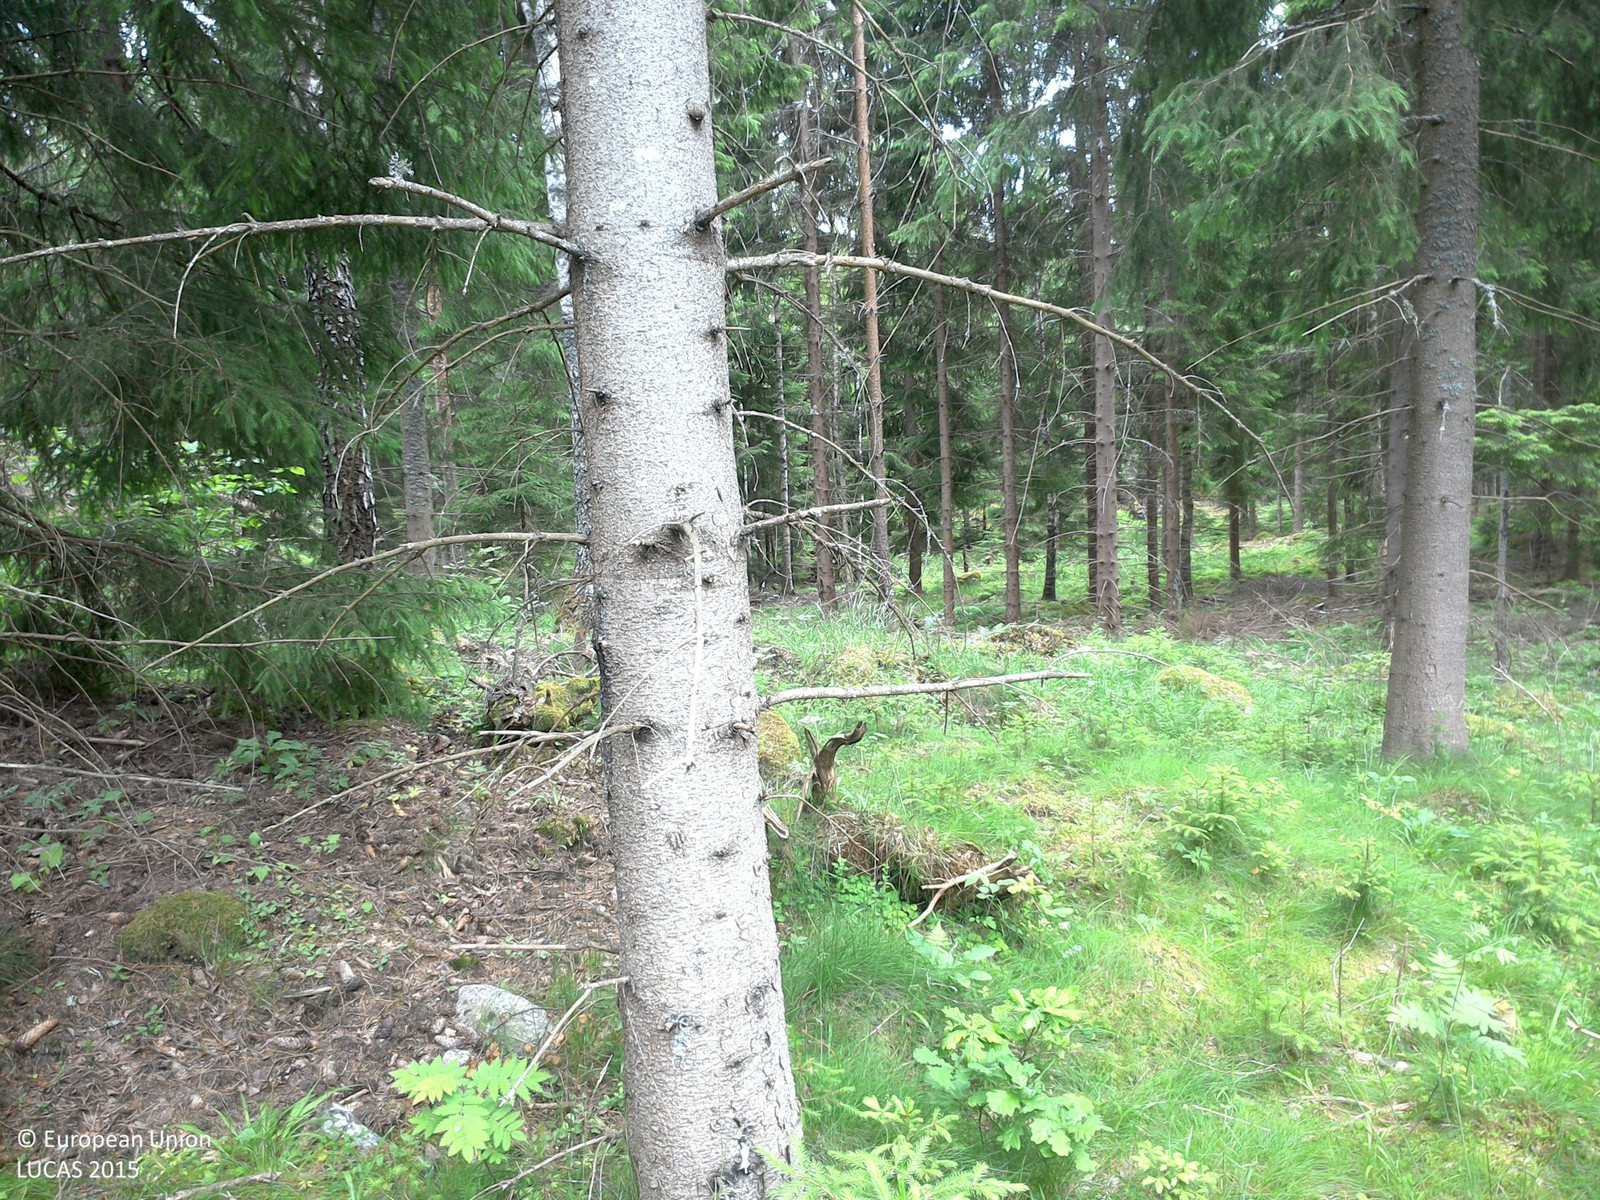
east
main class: Woodland
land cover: Spruce dominated coniferous woodland
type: boreal forest
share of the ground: 50 - 75 %
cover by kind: coniferous forest trees 65 %, herbaceous plants 20 %, lichens and mosses 15 %
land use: Forestry
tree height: > 5 m
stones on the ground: < 10 %
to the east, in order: Spruce dominated coniferous woodland; Pine dominated coniferous woodland; Spruce dominated coniferous woodland; Spruce dominated mixed woodland
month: June
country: SE
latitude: 57.9548
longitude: 15.6906
